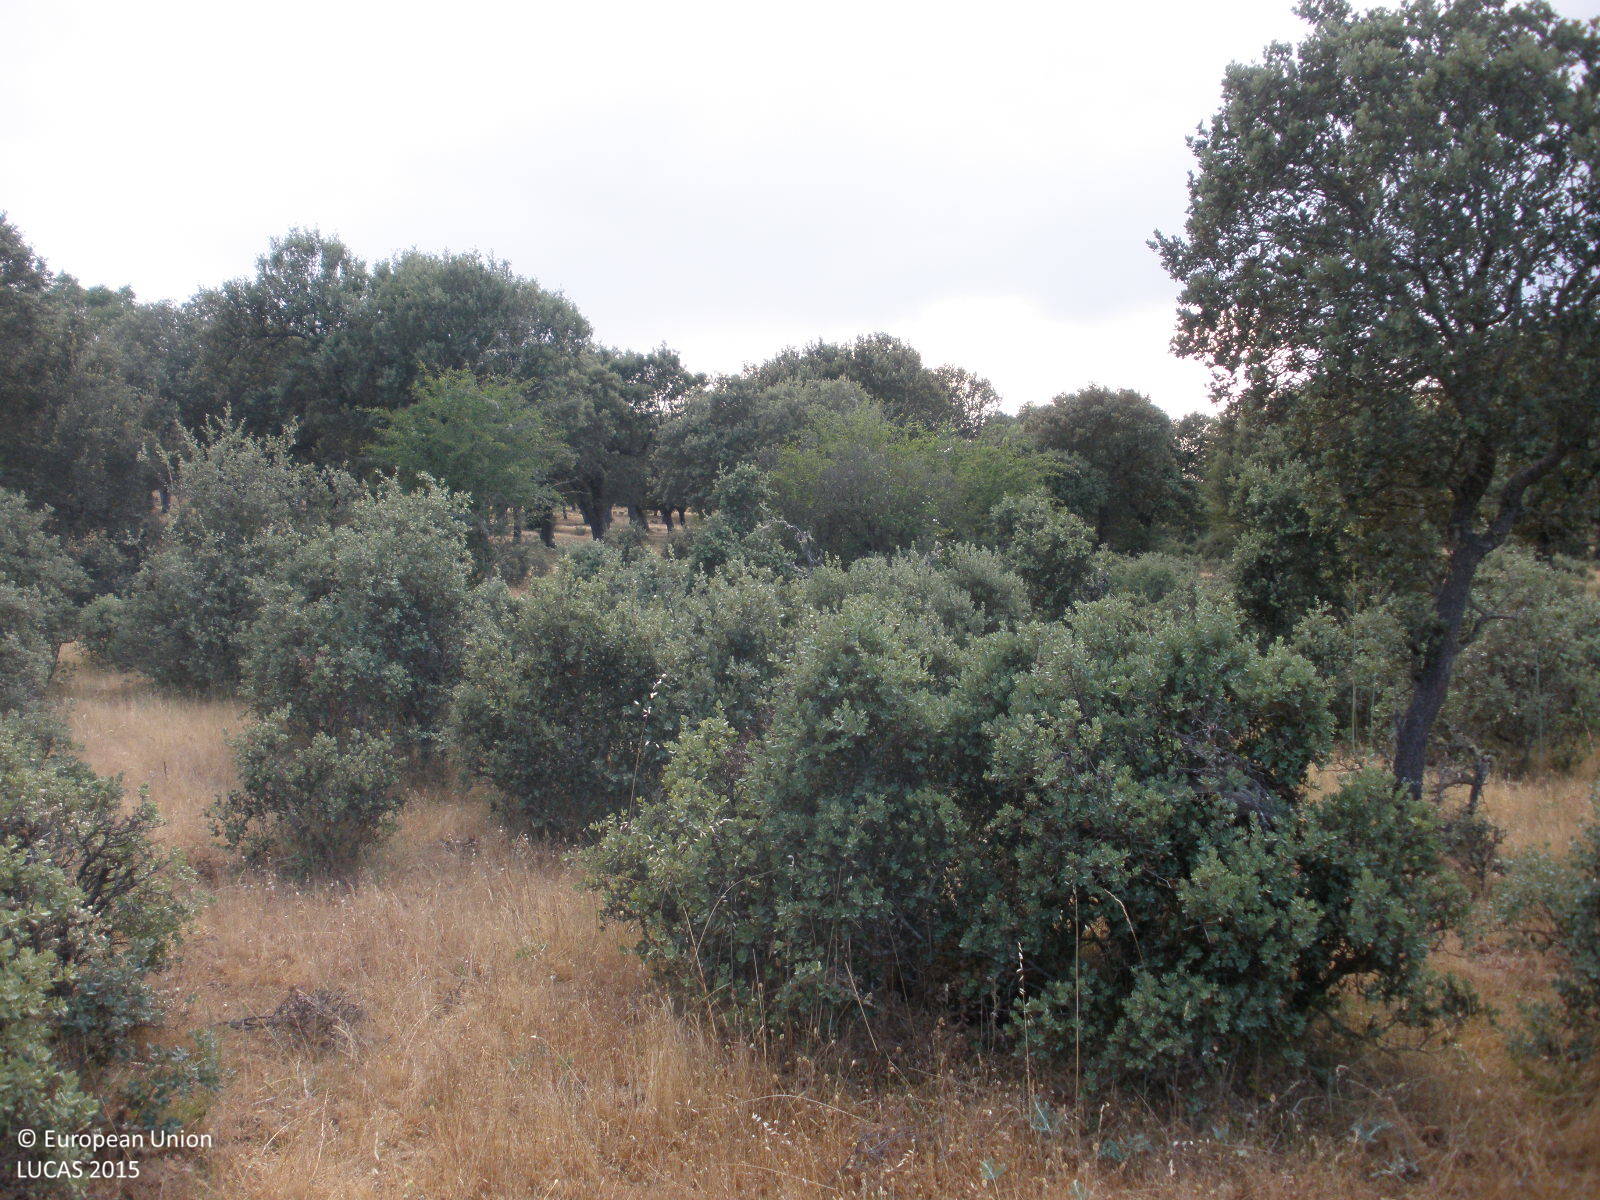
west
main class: Woodland
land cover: Broadleaved woodland
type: broadleaved evergreen forest
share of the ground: > 75 %
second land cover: Grassland without tree/shrub cover
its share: > 75 %
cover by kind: broadleaved forest trees 60 %, herbaceous plants 30 %, shrubs 10 %
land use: Forestry
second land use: Agriculture (excluding fallow land and kitchen gardens)
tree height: < 5 m
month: June
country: ES
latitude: 40.7251
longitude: -6.2464
